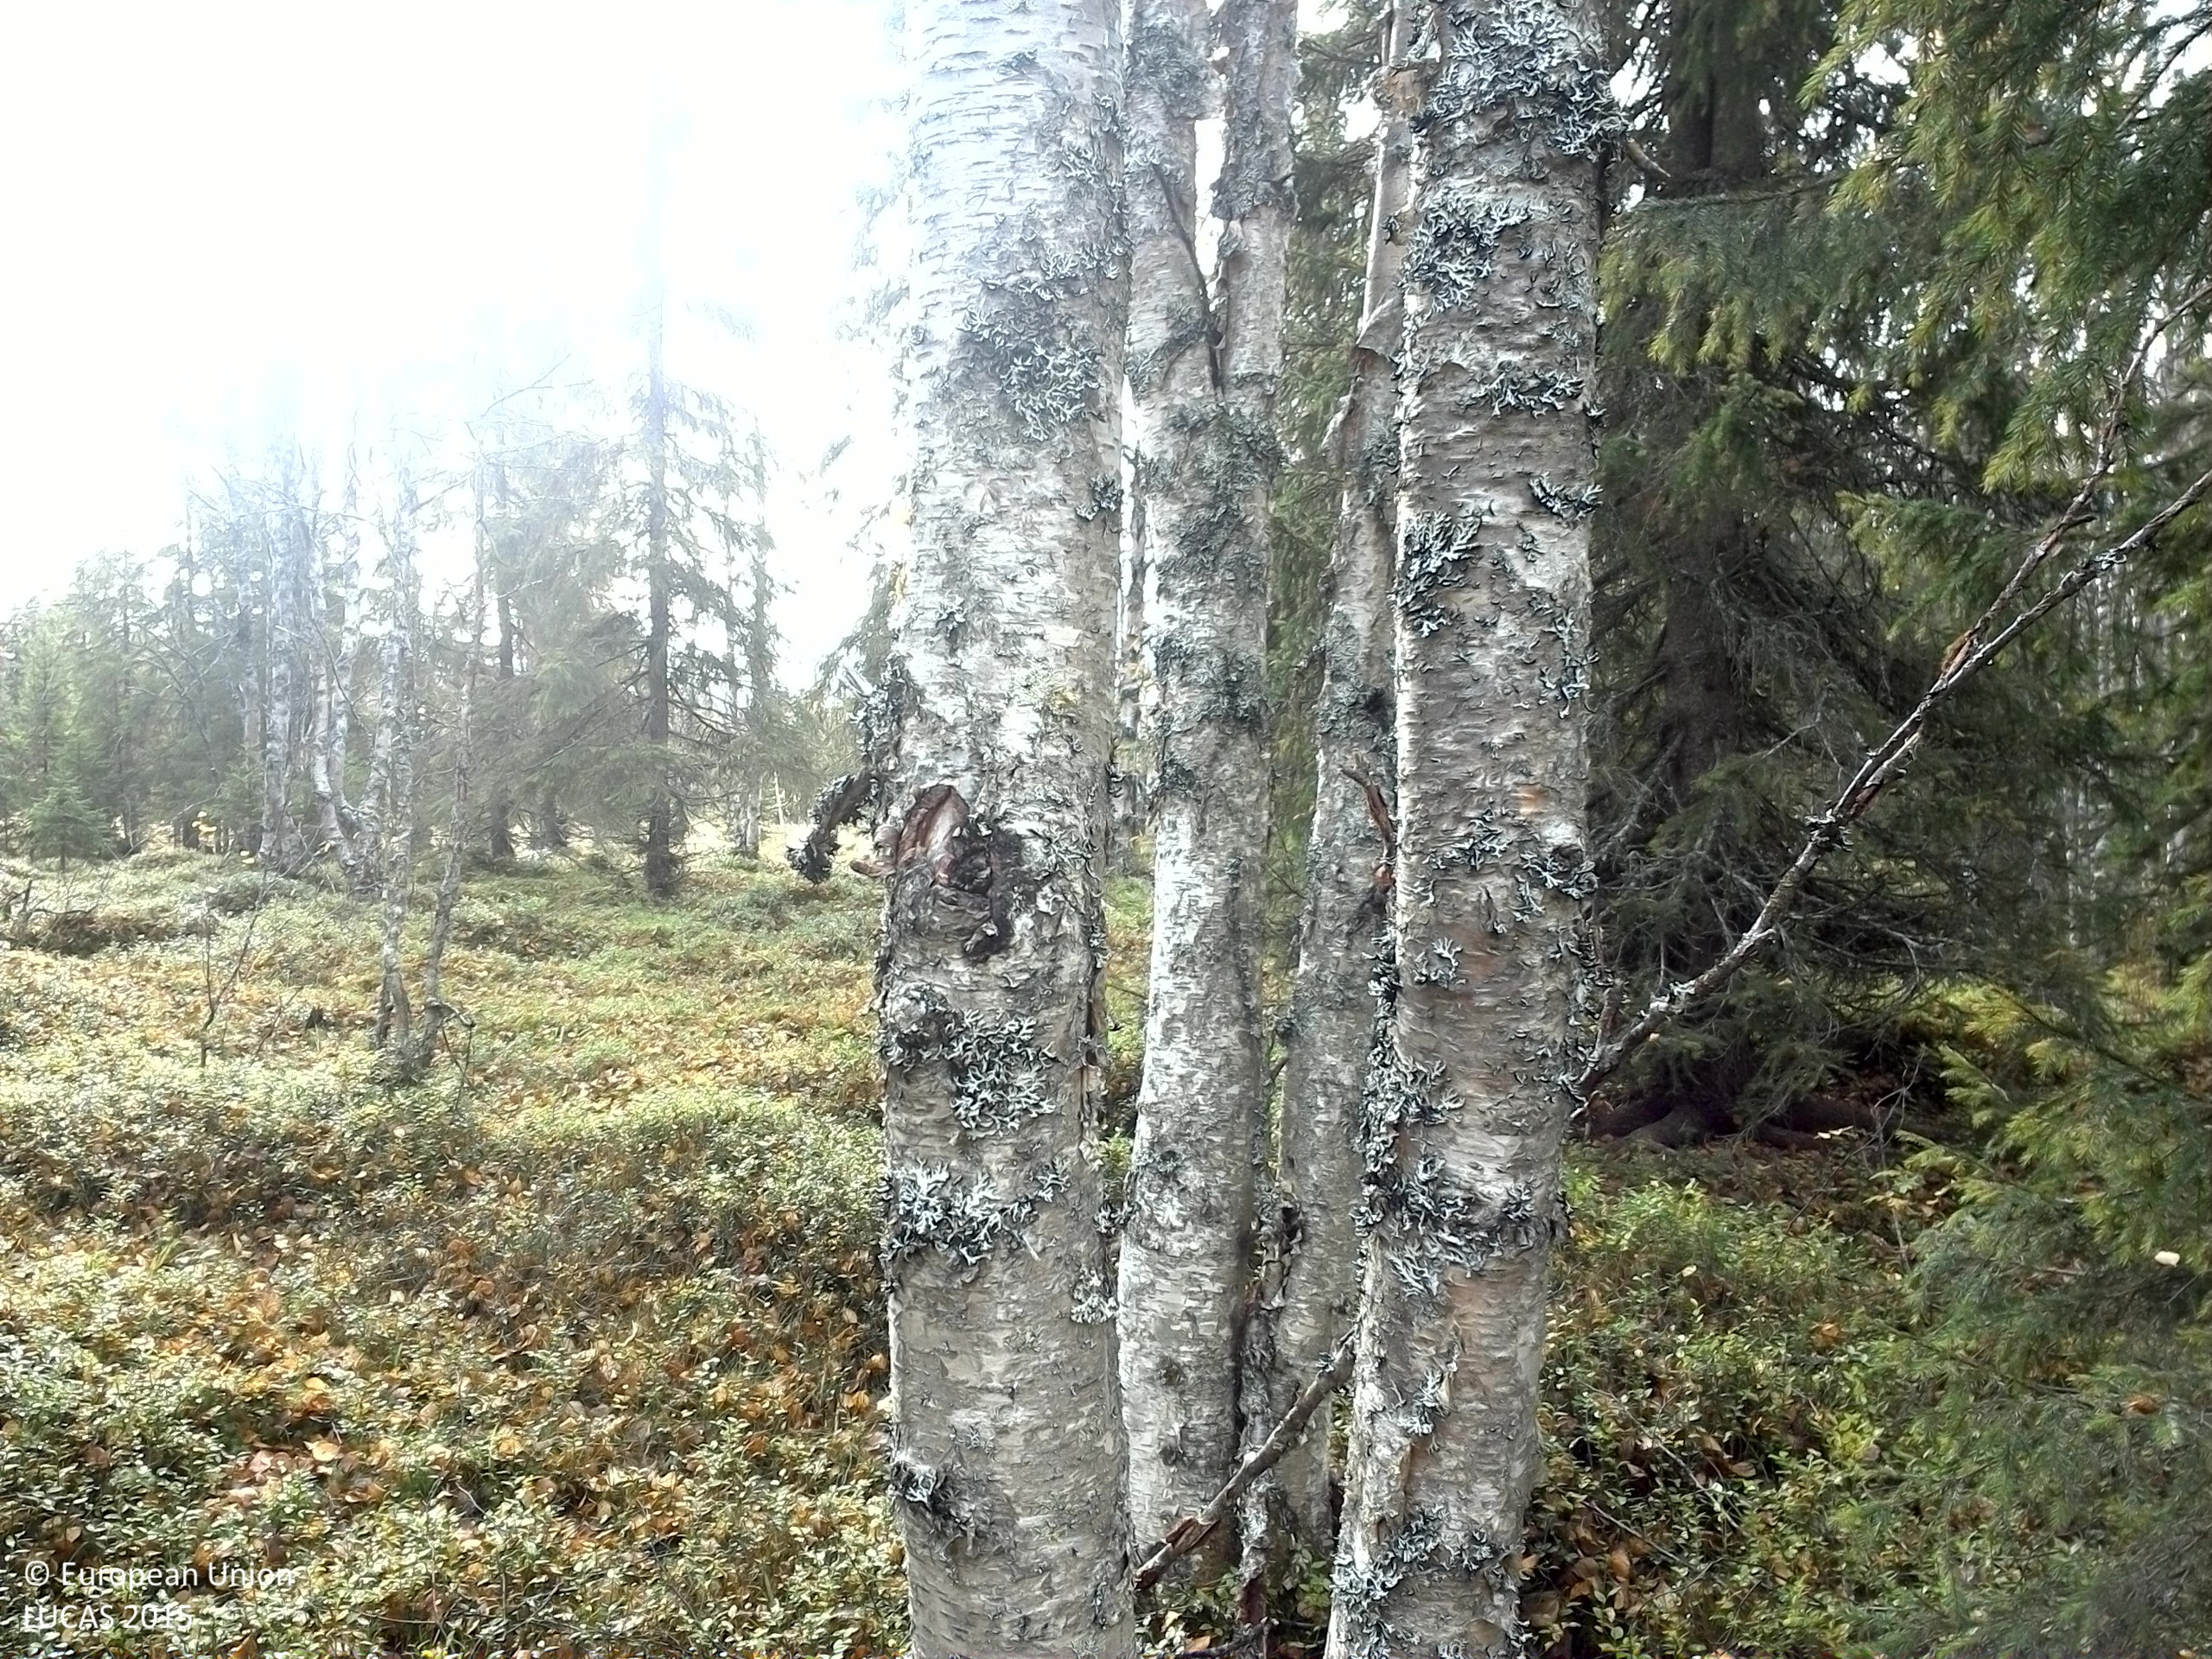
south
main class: Woodland
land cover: Spruce dominated mixed woodland
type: boreal forest
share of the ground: 50 - 75 %
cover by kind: coniferous forest trees 30 %, shrubs 30 %, broadleaved forest trees 20 %, lichens and mosses 15 %, herbaceous plants 5 %
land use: Forestry
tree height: > 5 m
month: October
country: SE
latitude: 64.3274
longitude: 15.8249
